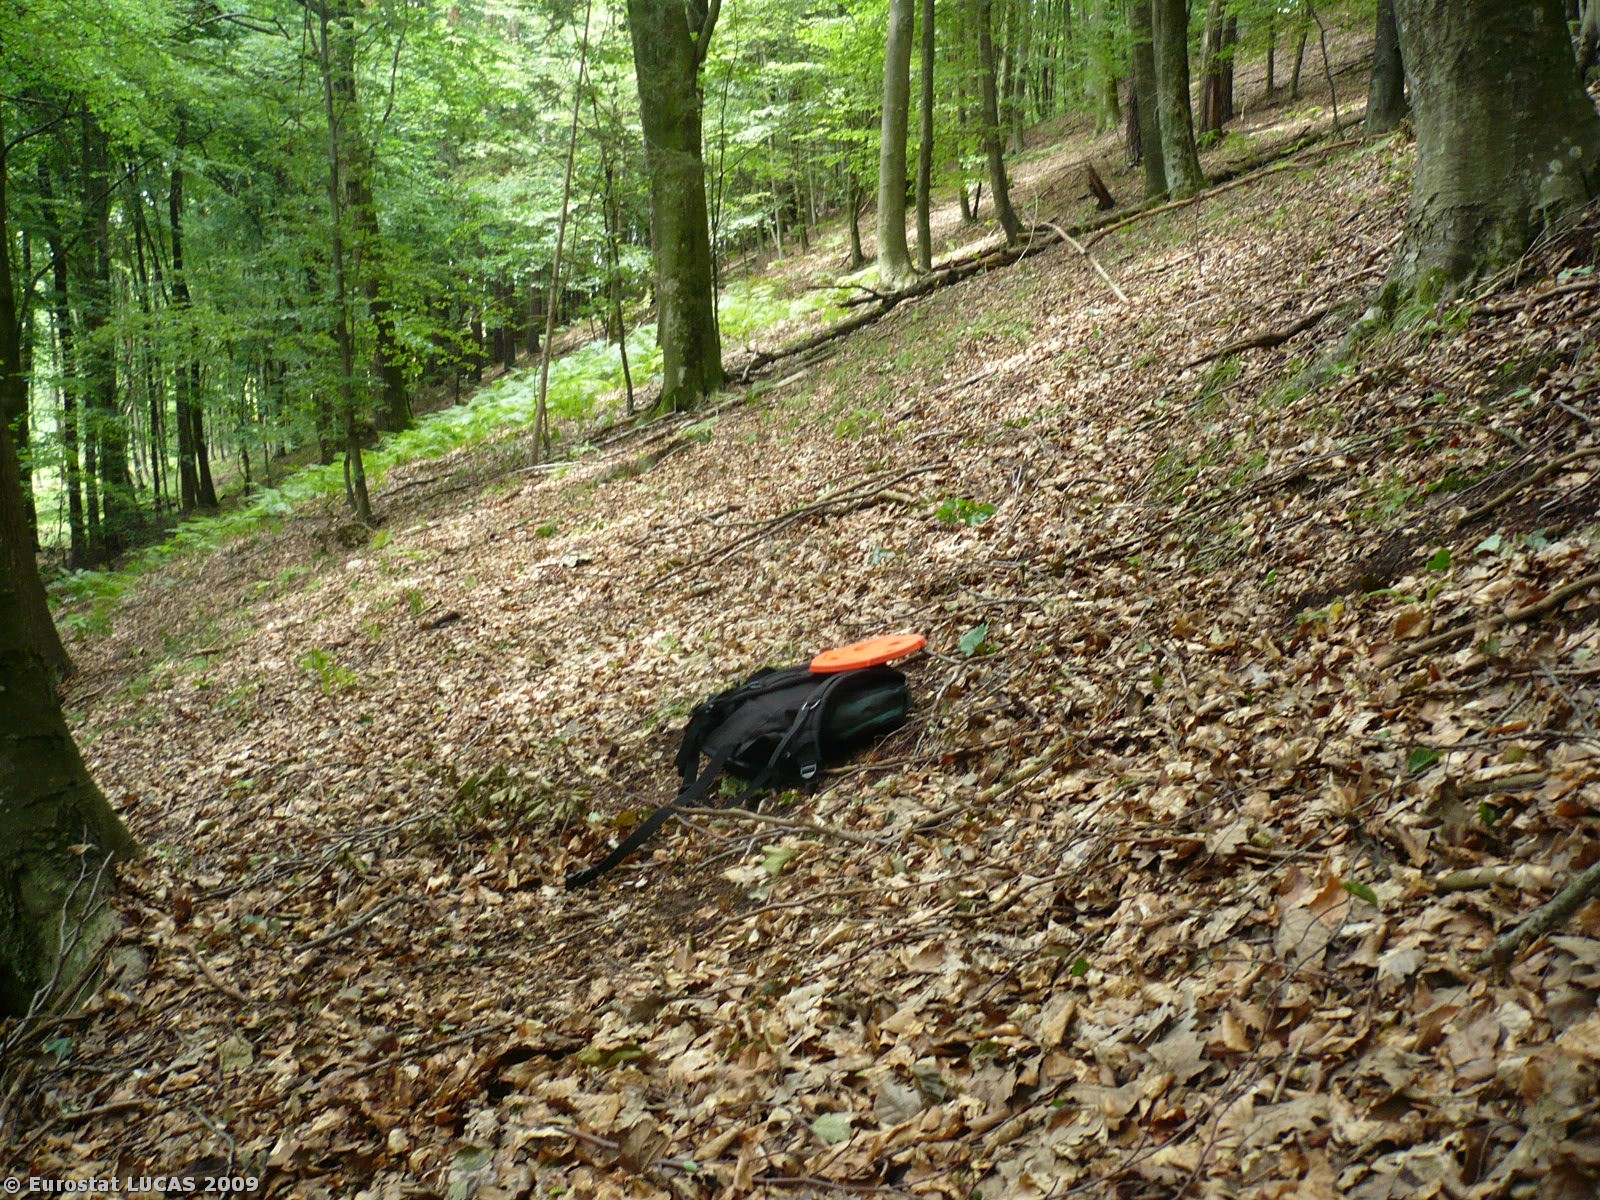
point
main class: Woodland
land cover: Broadleaved woodland
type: mesophytic deciduous forest
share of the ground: > 75 %
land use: Forestry
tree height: > 5 m
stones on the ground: < 10 %
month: June
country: SI
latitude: 46.5777
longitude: 16.0417
